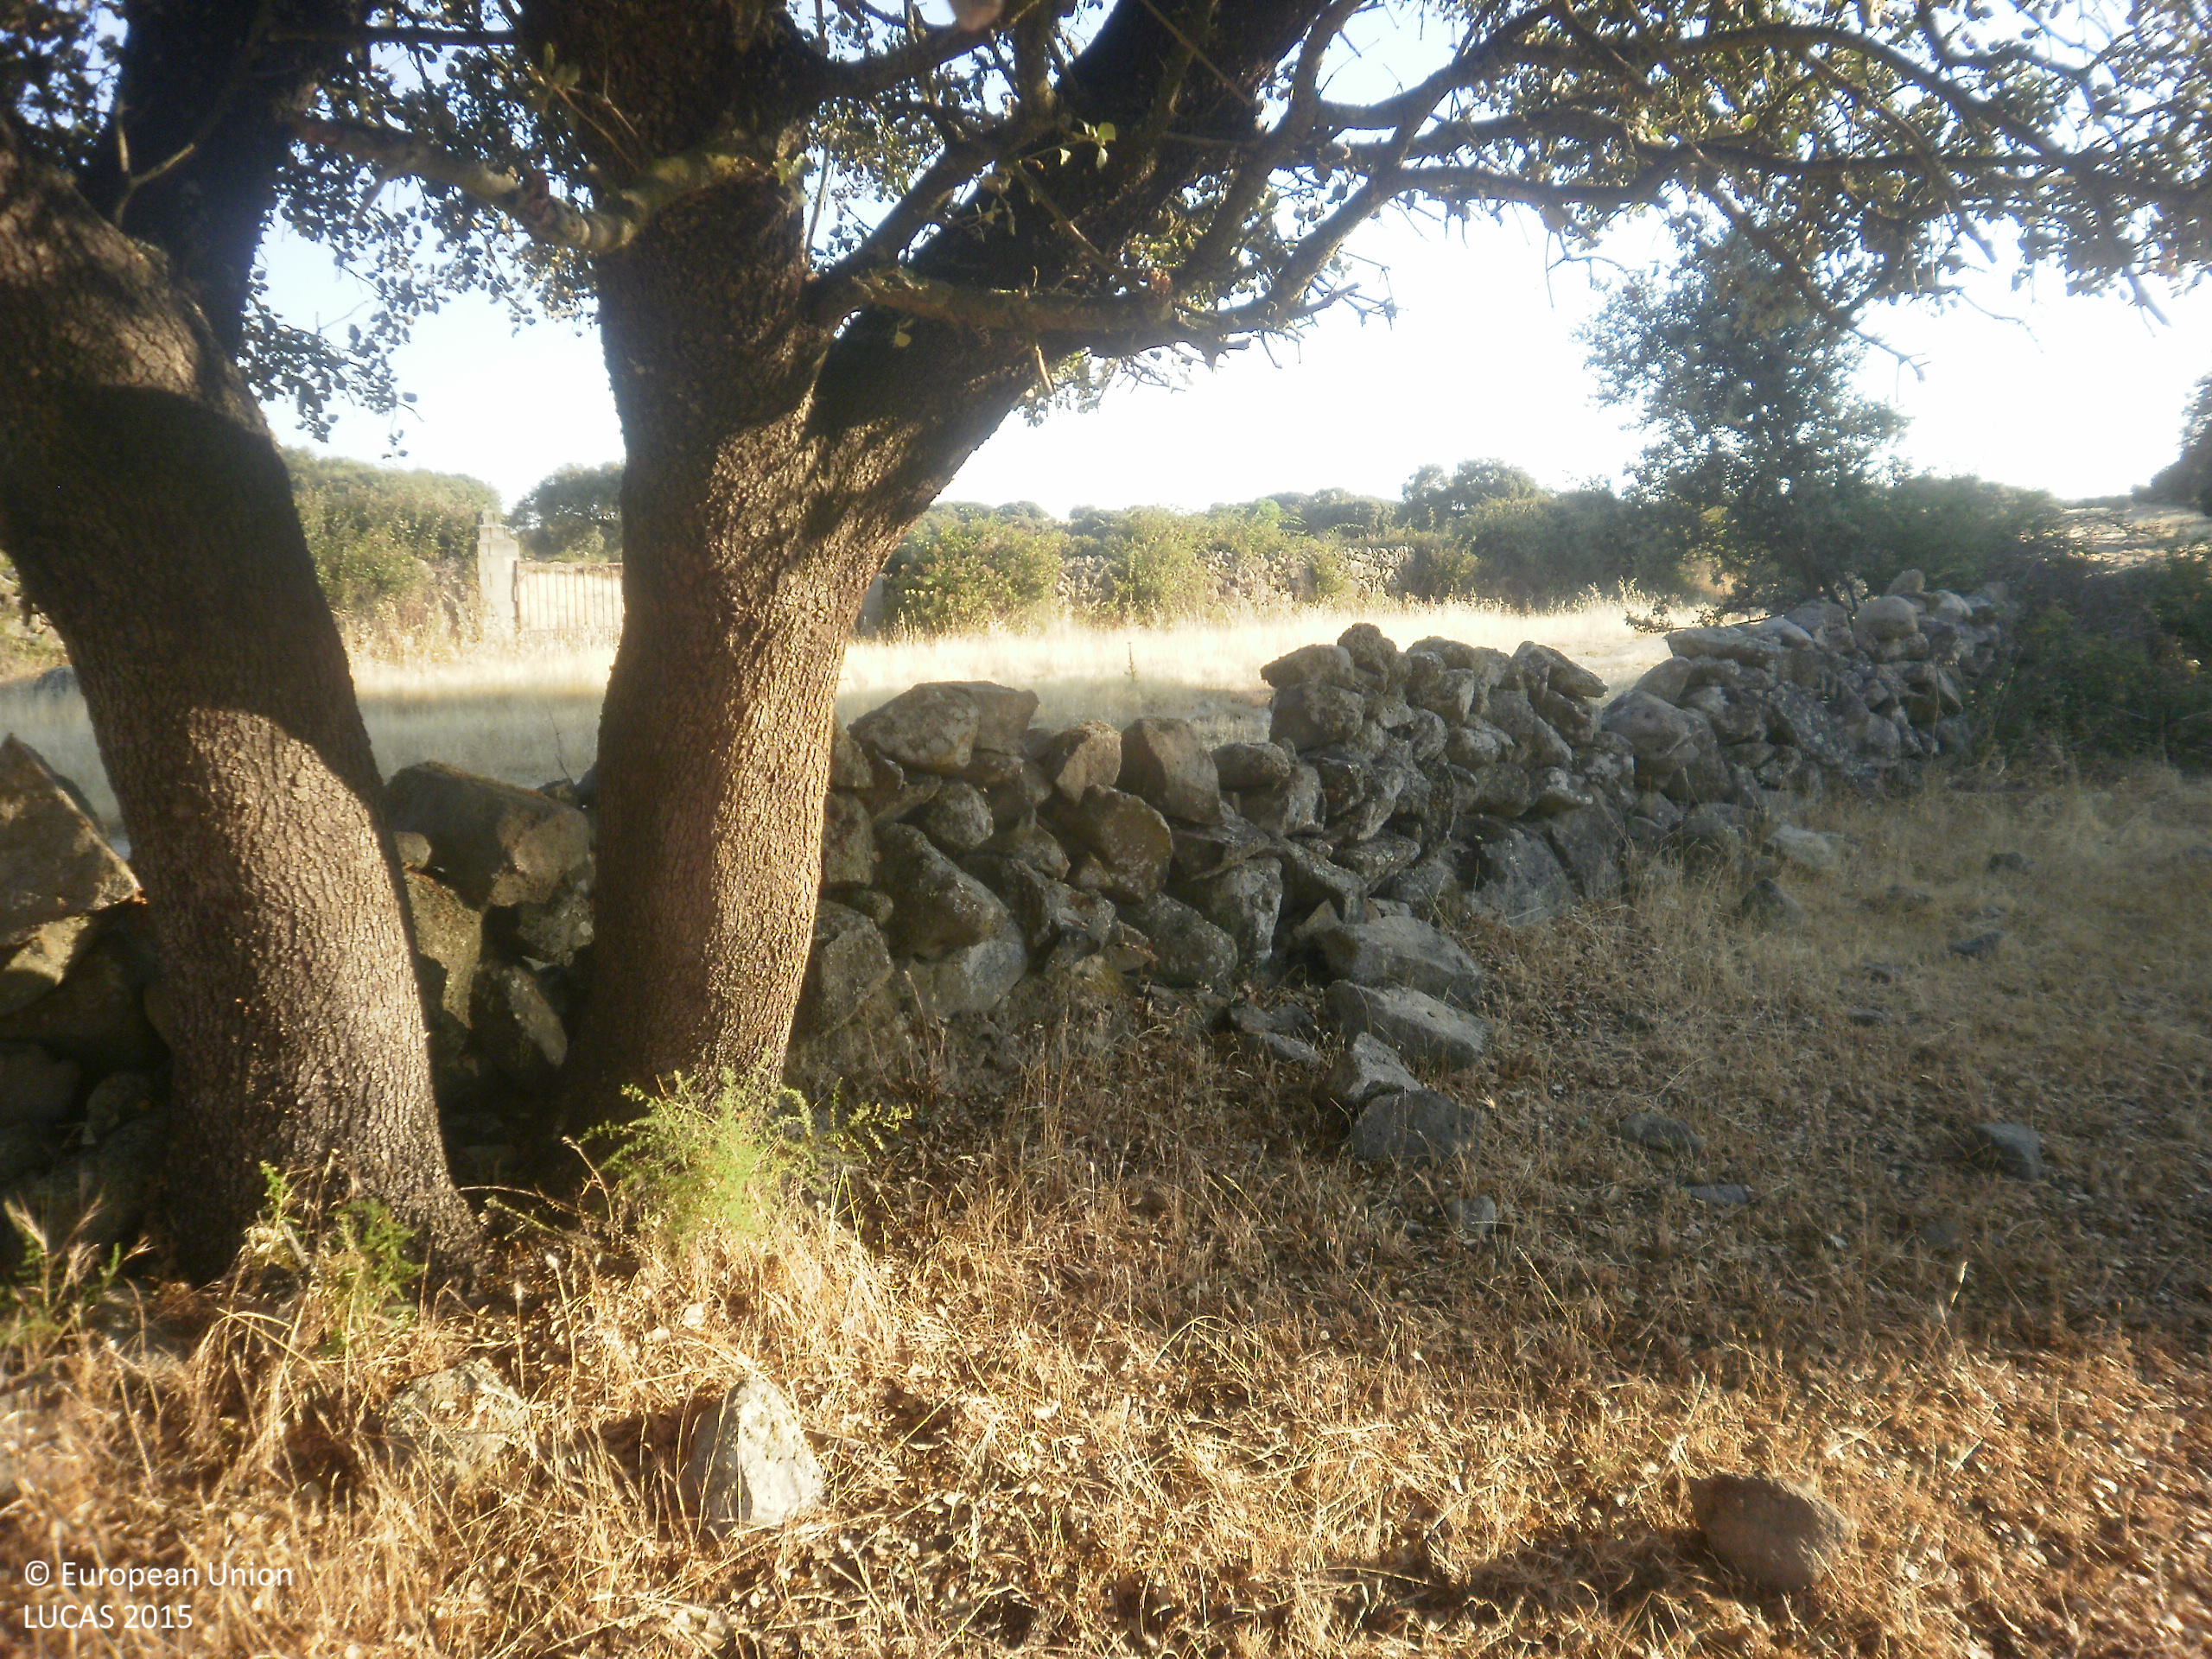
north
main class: Woodland
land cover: Broadleaved woodland
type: broadleaved evergreen forest
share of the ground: 10 - 25 %
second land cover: Grassland without tree/shrub cover
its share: 50 - 75 %
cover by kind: herbaceous plants 90 %, broadleaved forest trees 10 %
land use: Forestry
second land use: Agriculture (excluding fallow land and kitchen gardens)
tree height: > 5 m
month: June
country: ES
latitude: 39.2867
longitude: -6.0459
